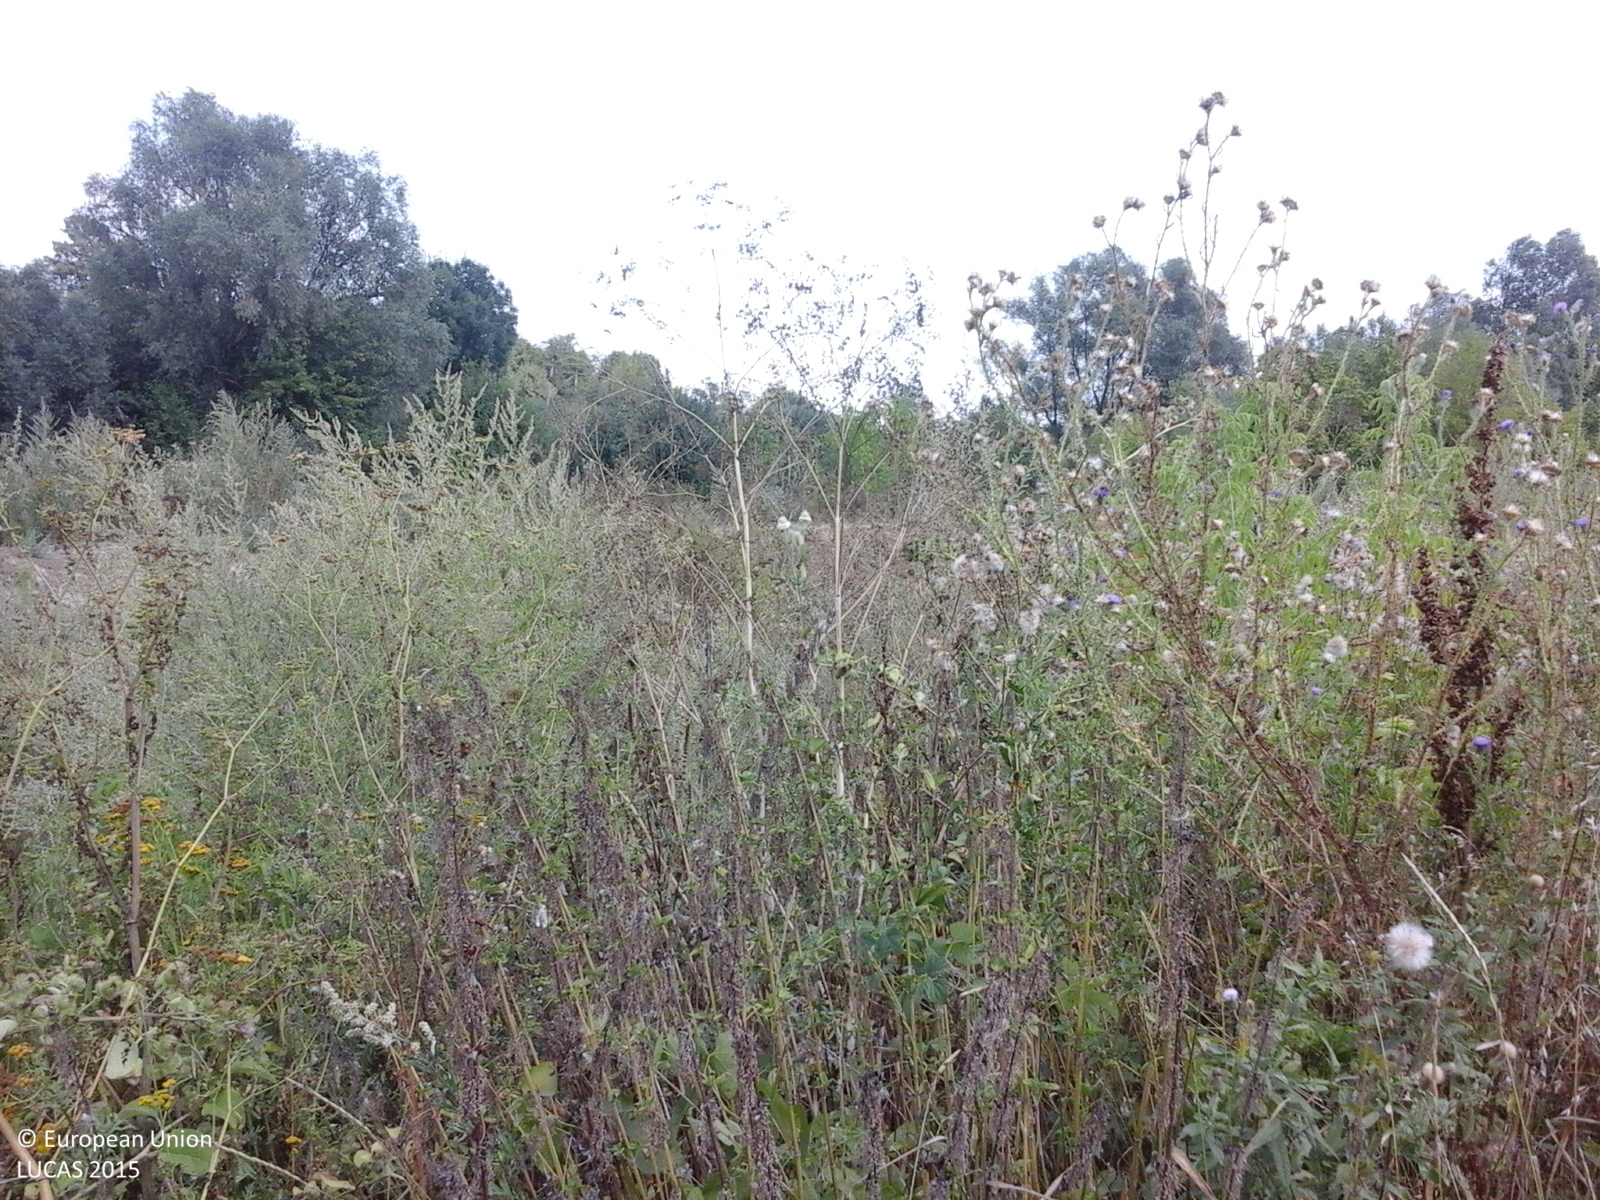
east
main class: Grassland
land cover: Spontaneously vegetated surfaces
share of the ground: > 75 %
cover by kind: herbaceous plants 100 %
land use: Fallow land
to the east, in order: Spontaneously vegetated surfaces; Rivers and streams; Spontaneously vegetated surfaces; Tracks; Lines of trees; Grass margins; Other fresh vegetables; Spontaneously vegetated surfaces; Broadleaved woodland; Maize; Artificial constructions in urban areas; Grassland with sparse tree/shrub cover; Artificial constructions in urban areas; Spontaneously vegetated surfaces; Artificial constructions in urban areas
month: August
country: RO
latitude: 44.3231
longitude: 23.3535
